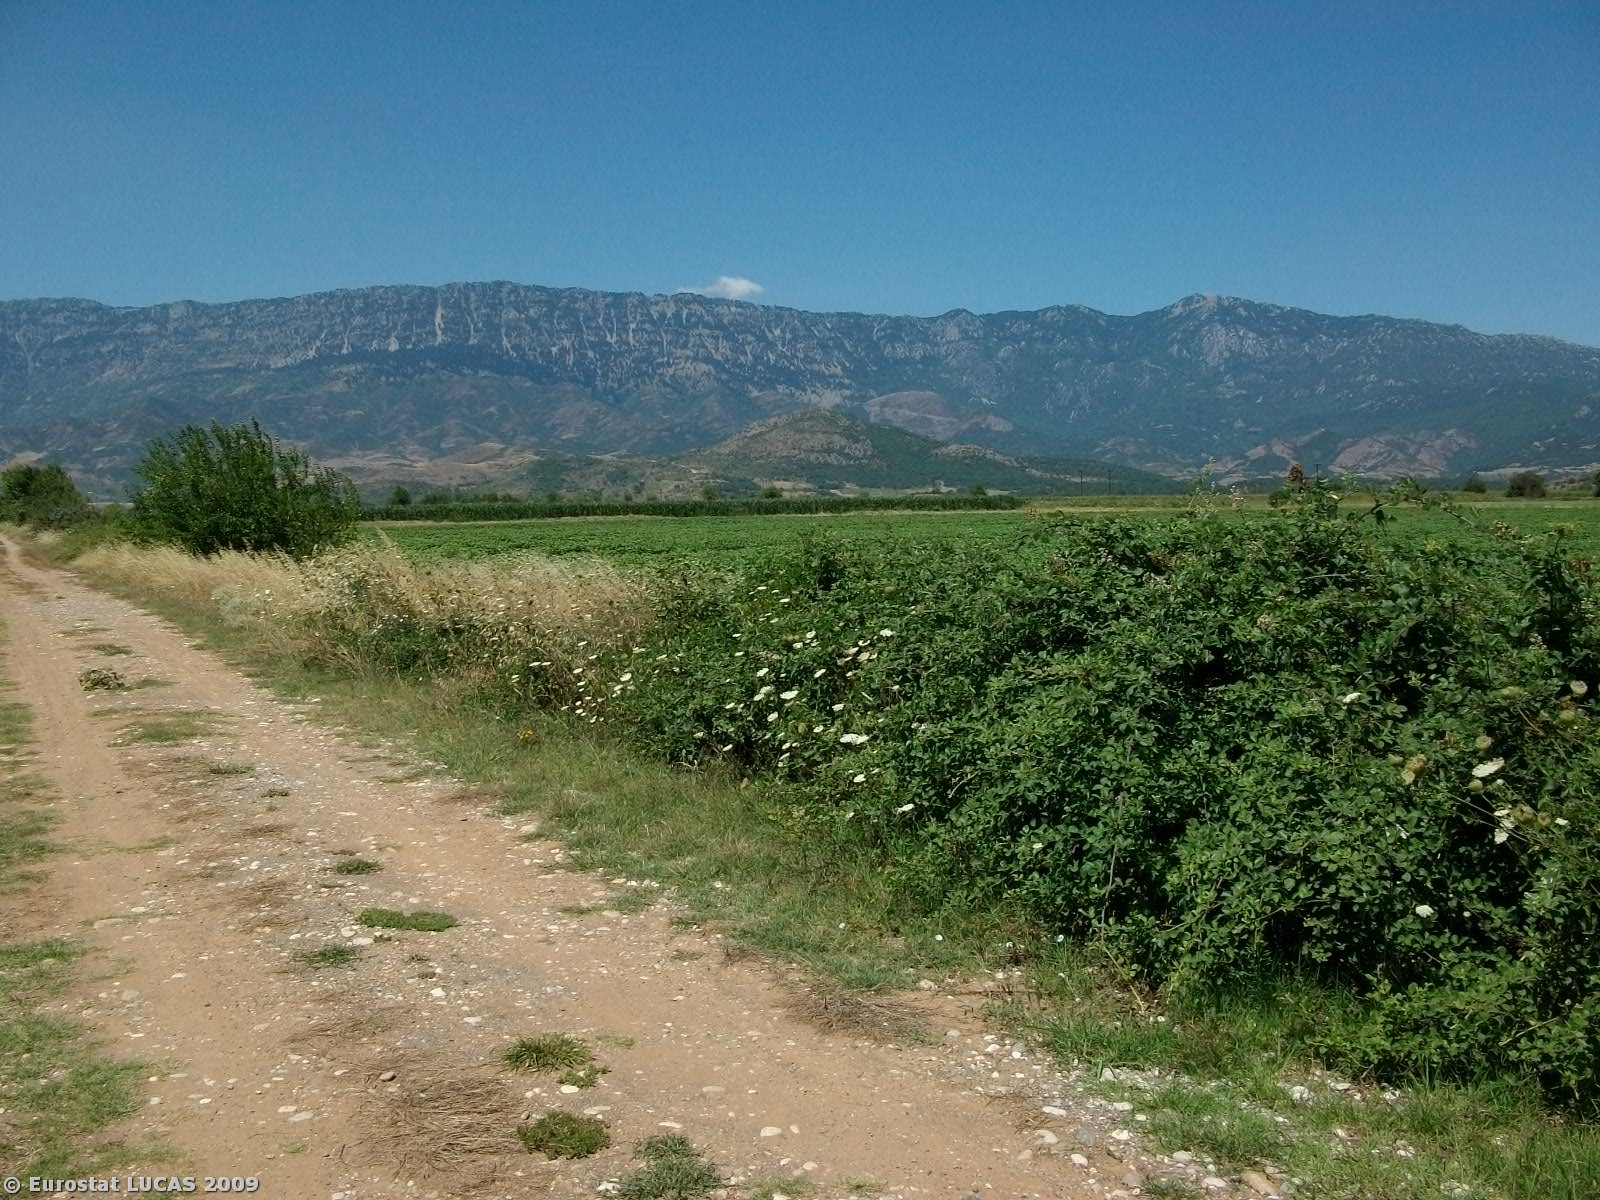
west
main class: Cropland
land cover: Maize
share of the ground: > 75 %
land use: Agriculture (excluding fallow land and kitchen gardens)
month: July
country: GR
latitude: 39.6234
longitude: 21.6679
